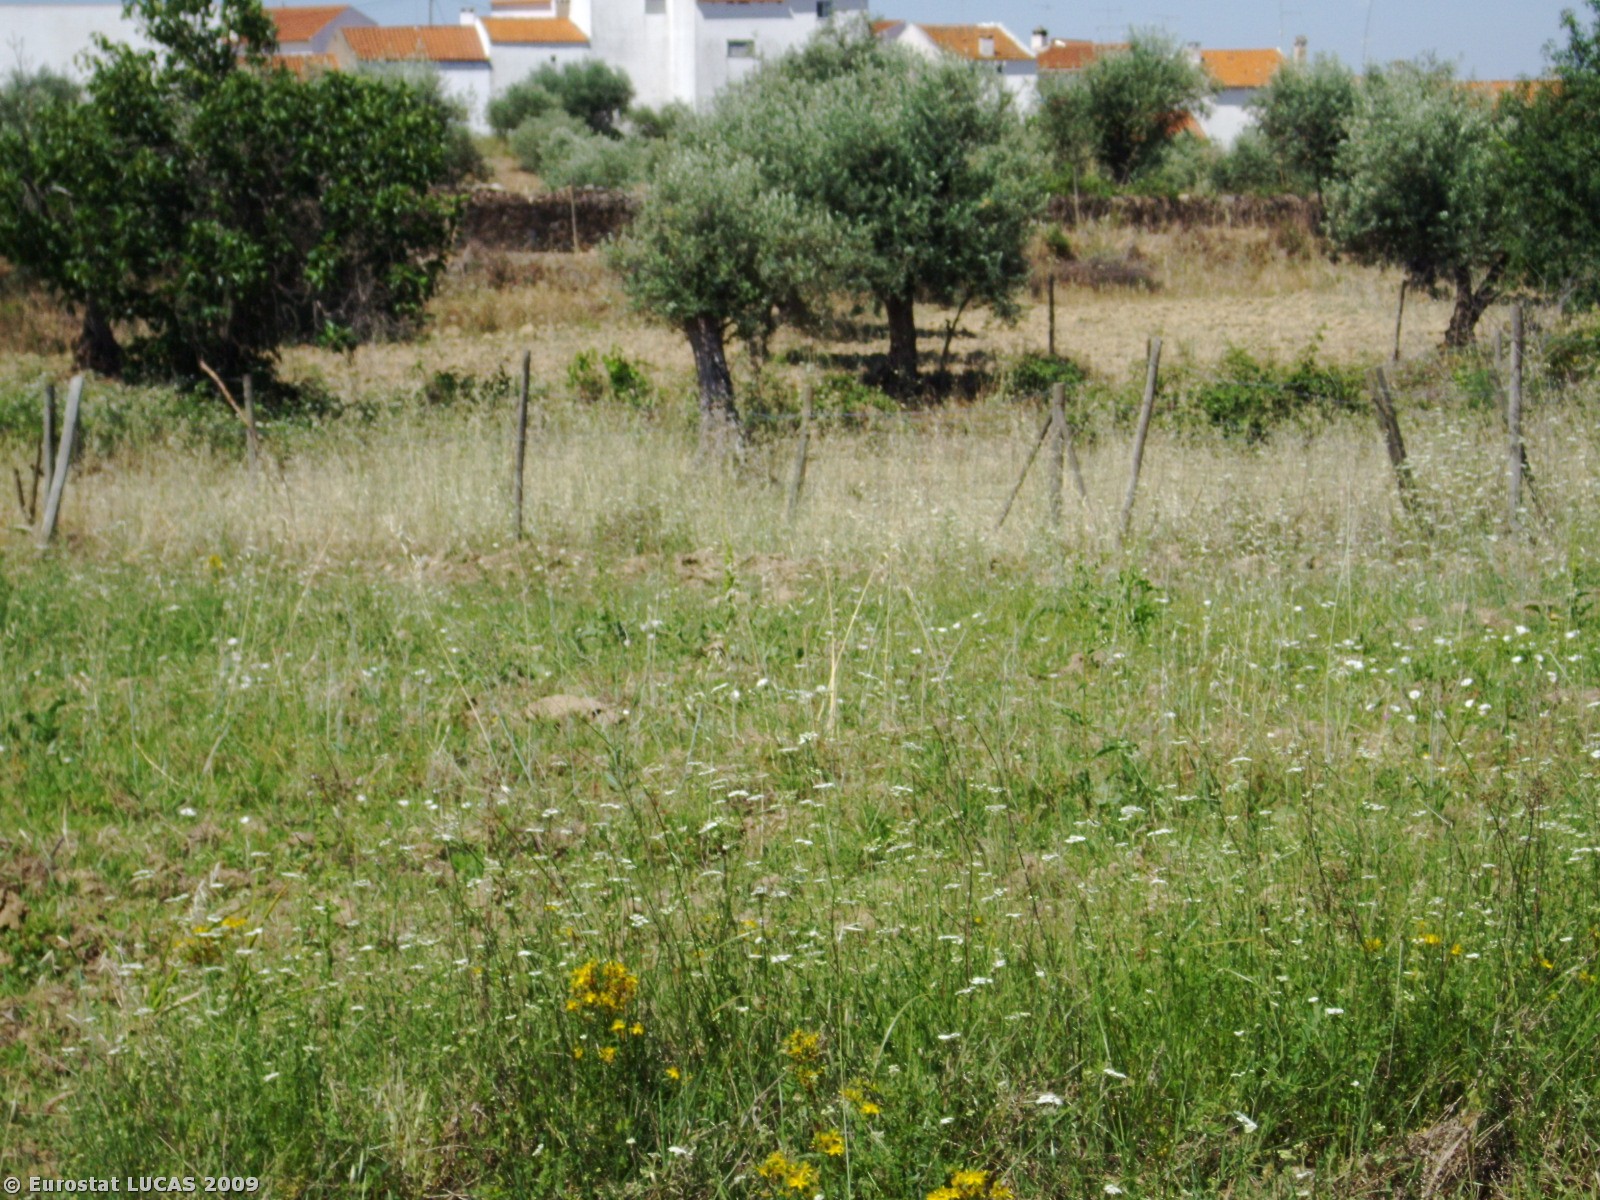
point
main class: Grassland
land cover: Spontaneously vegetated surfaces
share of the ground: > 75 %
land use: Fallow land
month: June
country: PT
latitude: 39.8319
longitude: -7.2583
